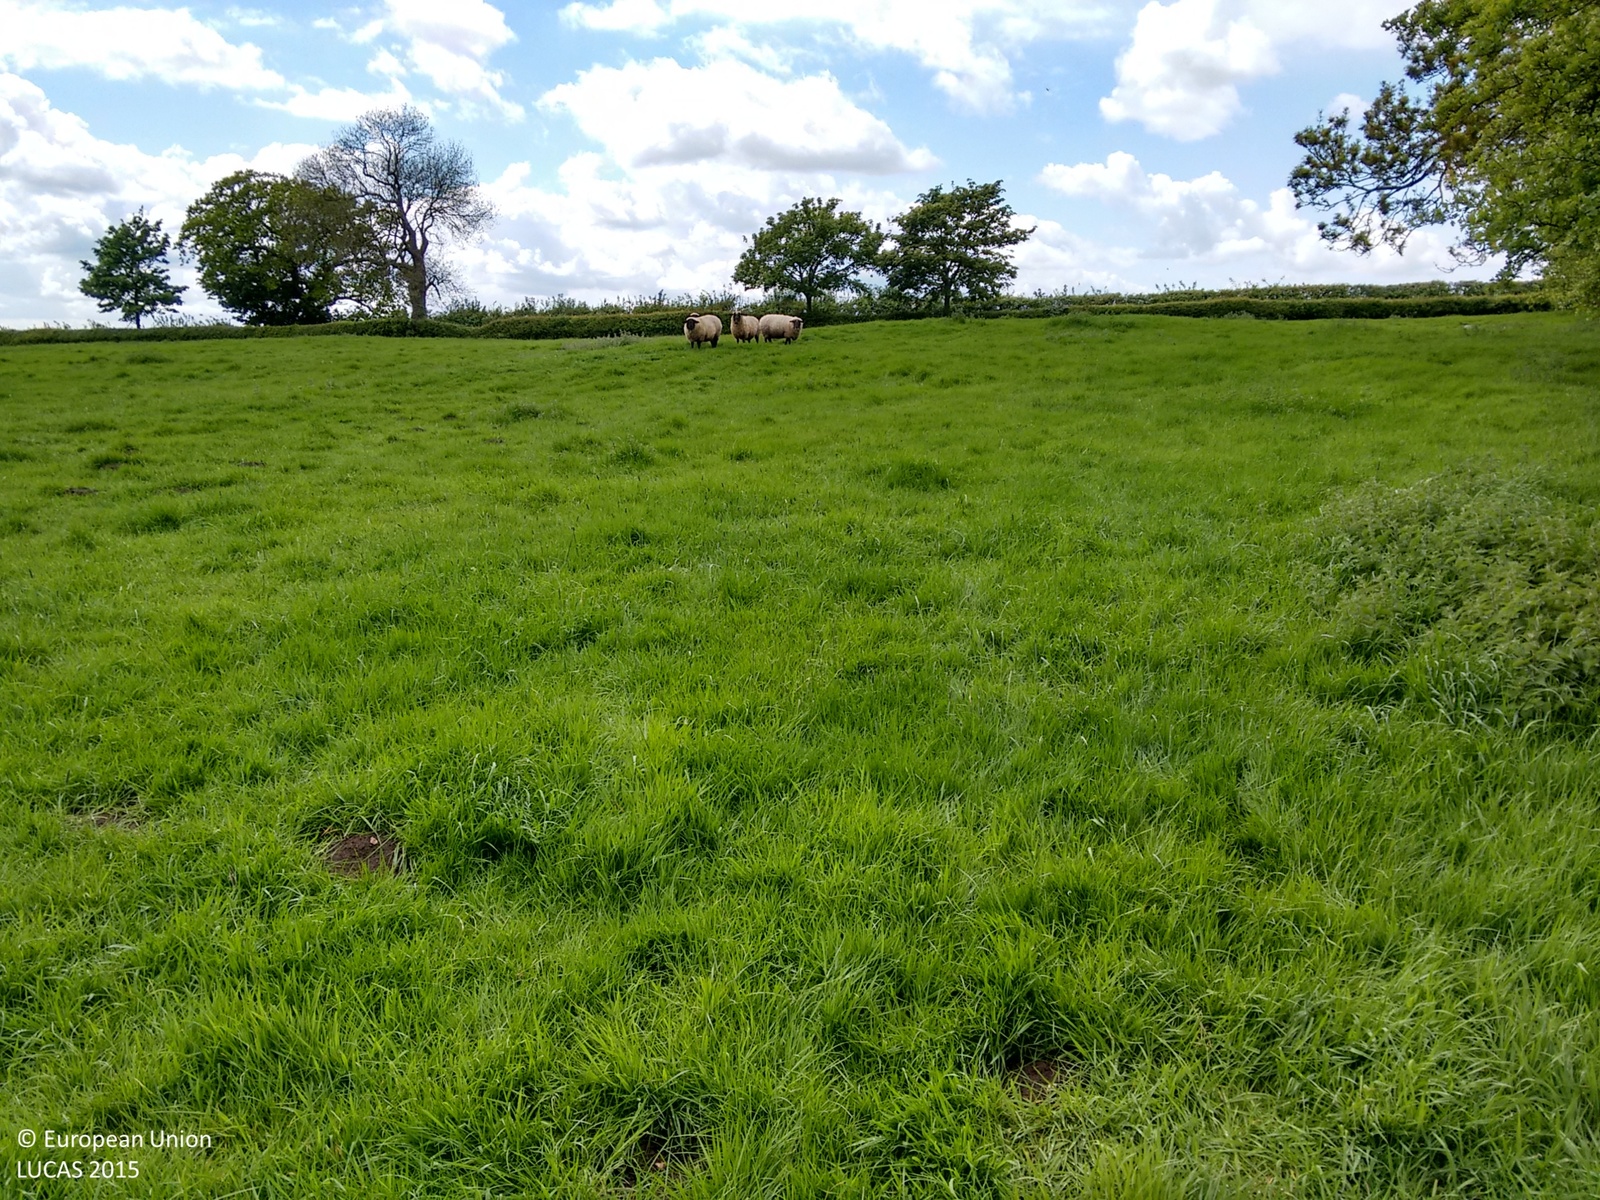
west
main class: Grassland
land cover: Grassland without tree/shrub cover
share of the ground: > 75 %
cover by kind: herbaceous plants 100 %
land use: Agriculture (excluding fallow land and kitchen gardens)
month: May
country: GB
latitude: 53.3657
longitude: -0.2384
